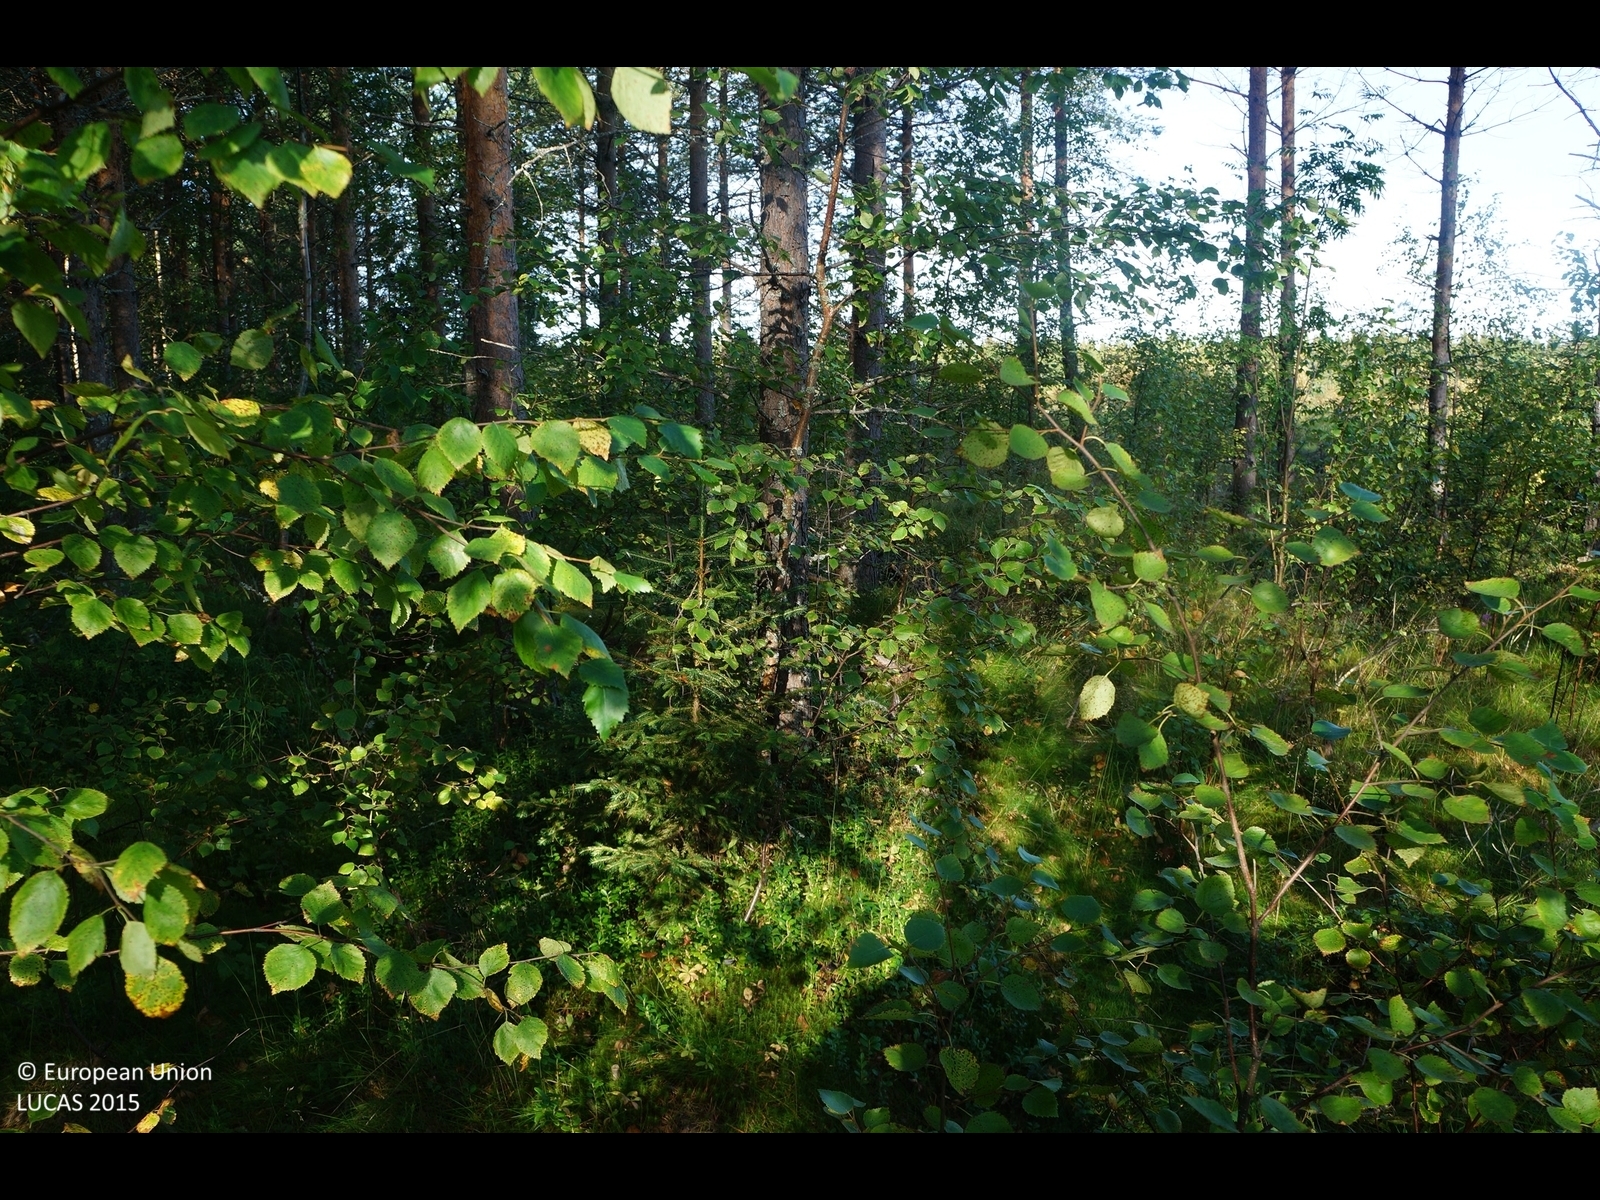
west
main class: Woodland
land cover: Pine dominated coniferous woodland
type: boreal forest
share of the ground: 50 - 75 %
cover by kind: coniferous forest trees 50 %, shrubs 35 %, lichens and mosses 10 %, herbaceous plants 5 %
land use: Forestry
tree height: > 5 m
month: August
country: FI
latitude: 64.8757
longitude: 25.0415
